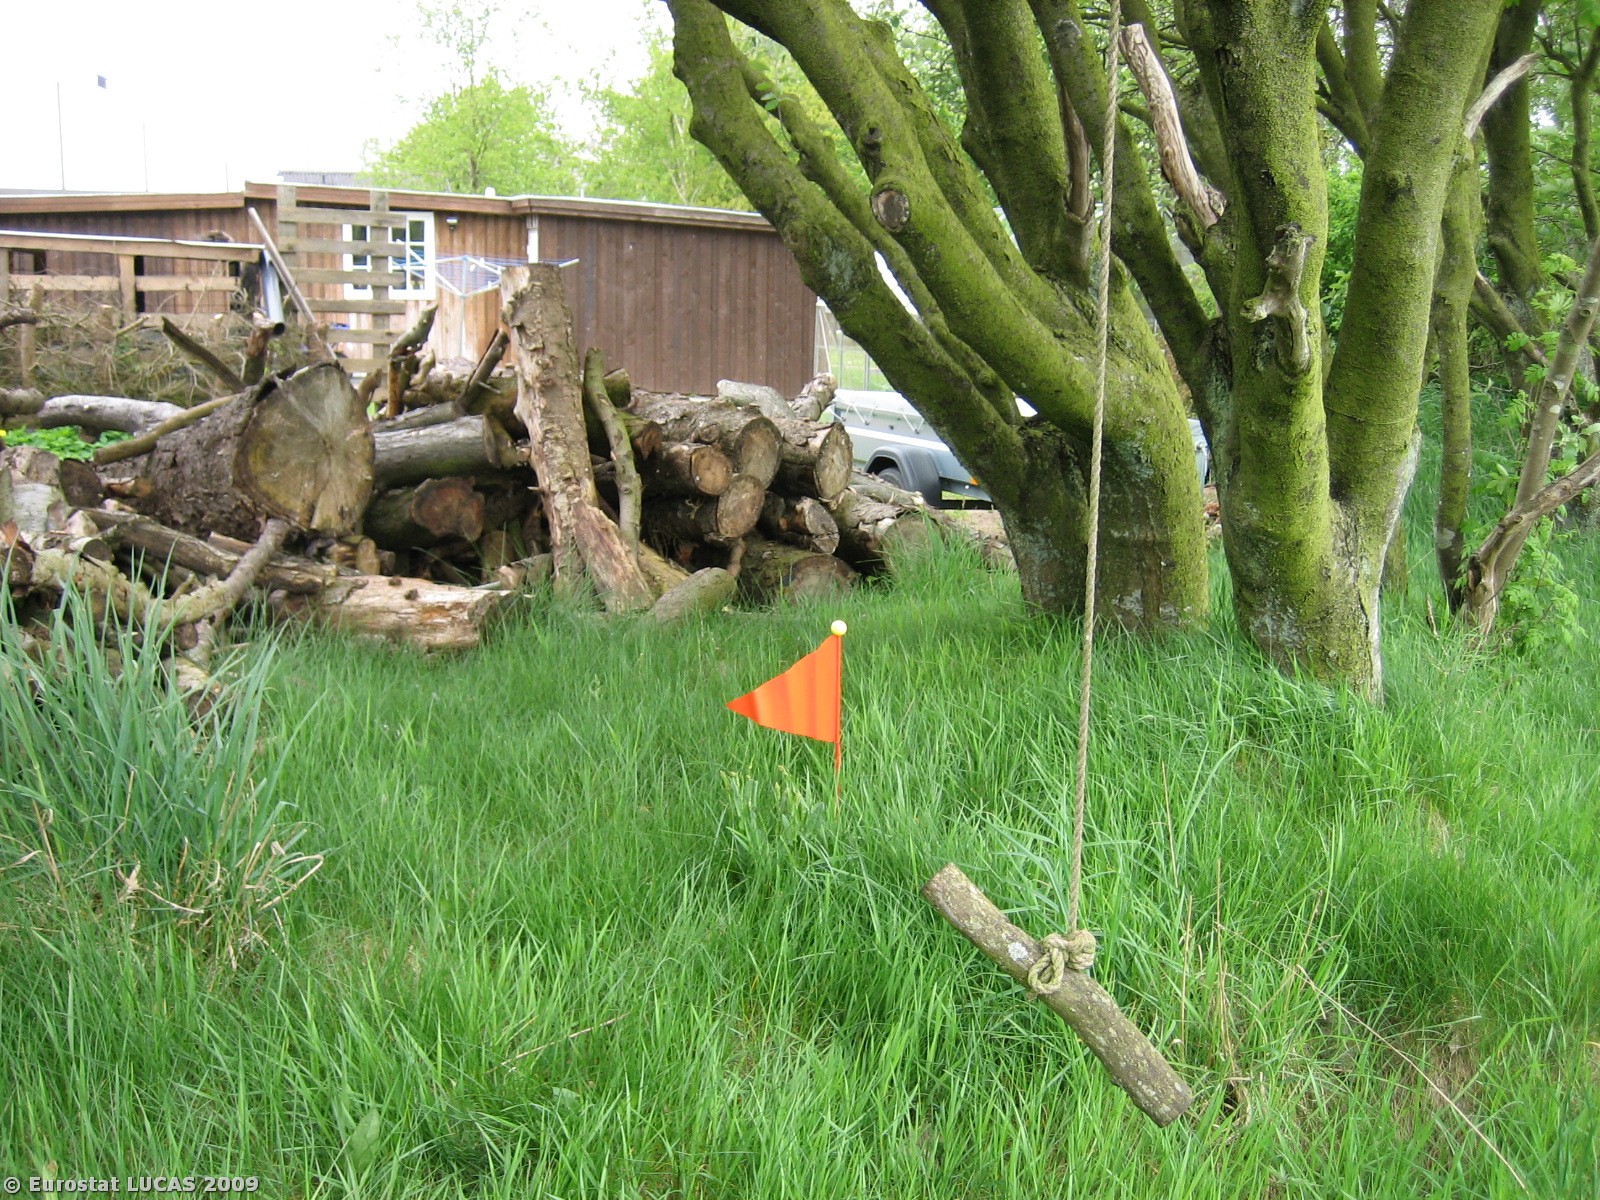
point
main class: Woodland
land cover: Broadleaved woodland
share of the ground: 50 - 75 %
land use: Unused
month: May
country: DK
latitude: 56.1794
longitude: 8.5357
